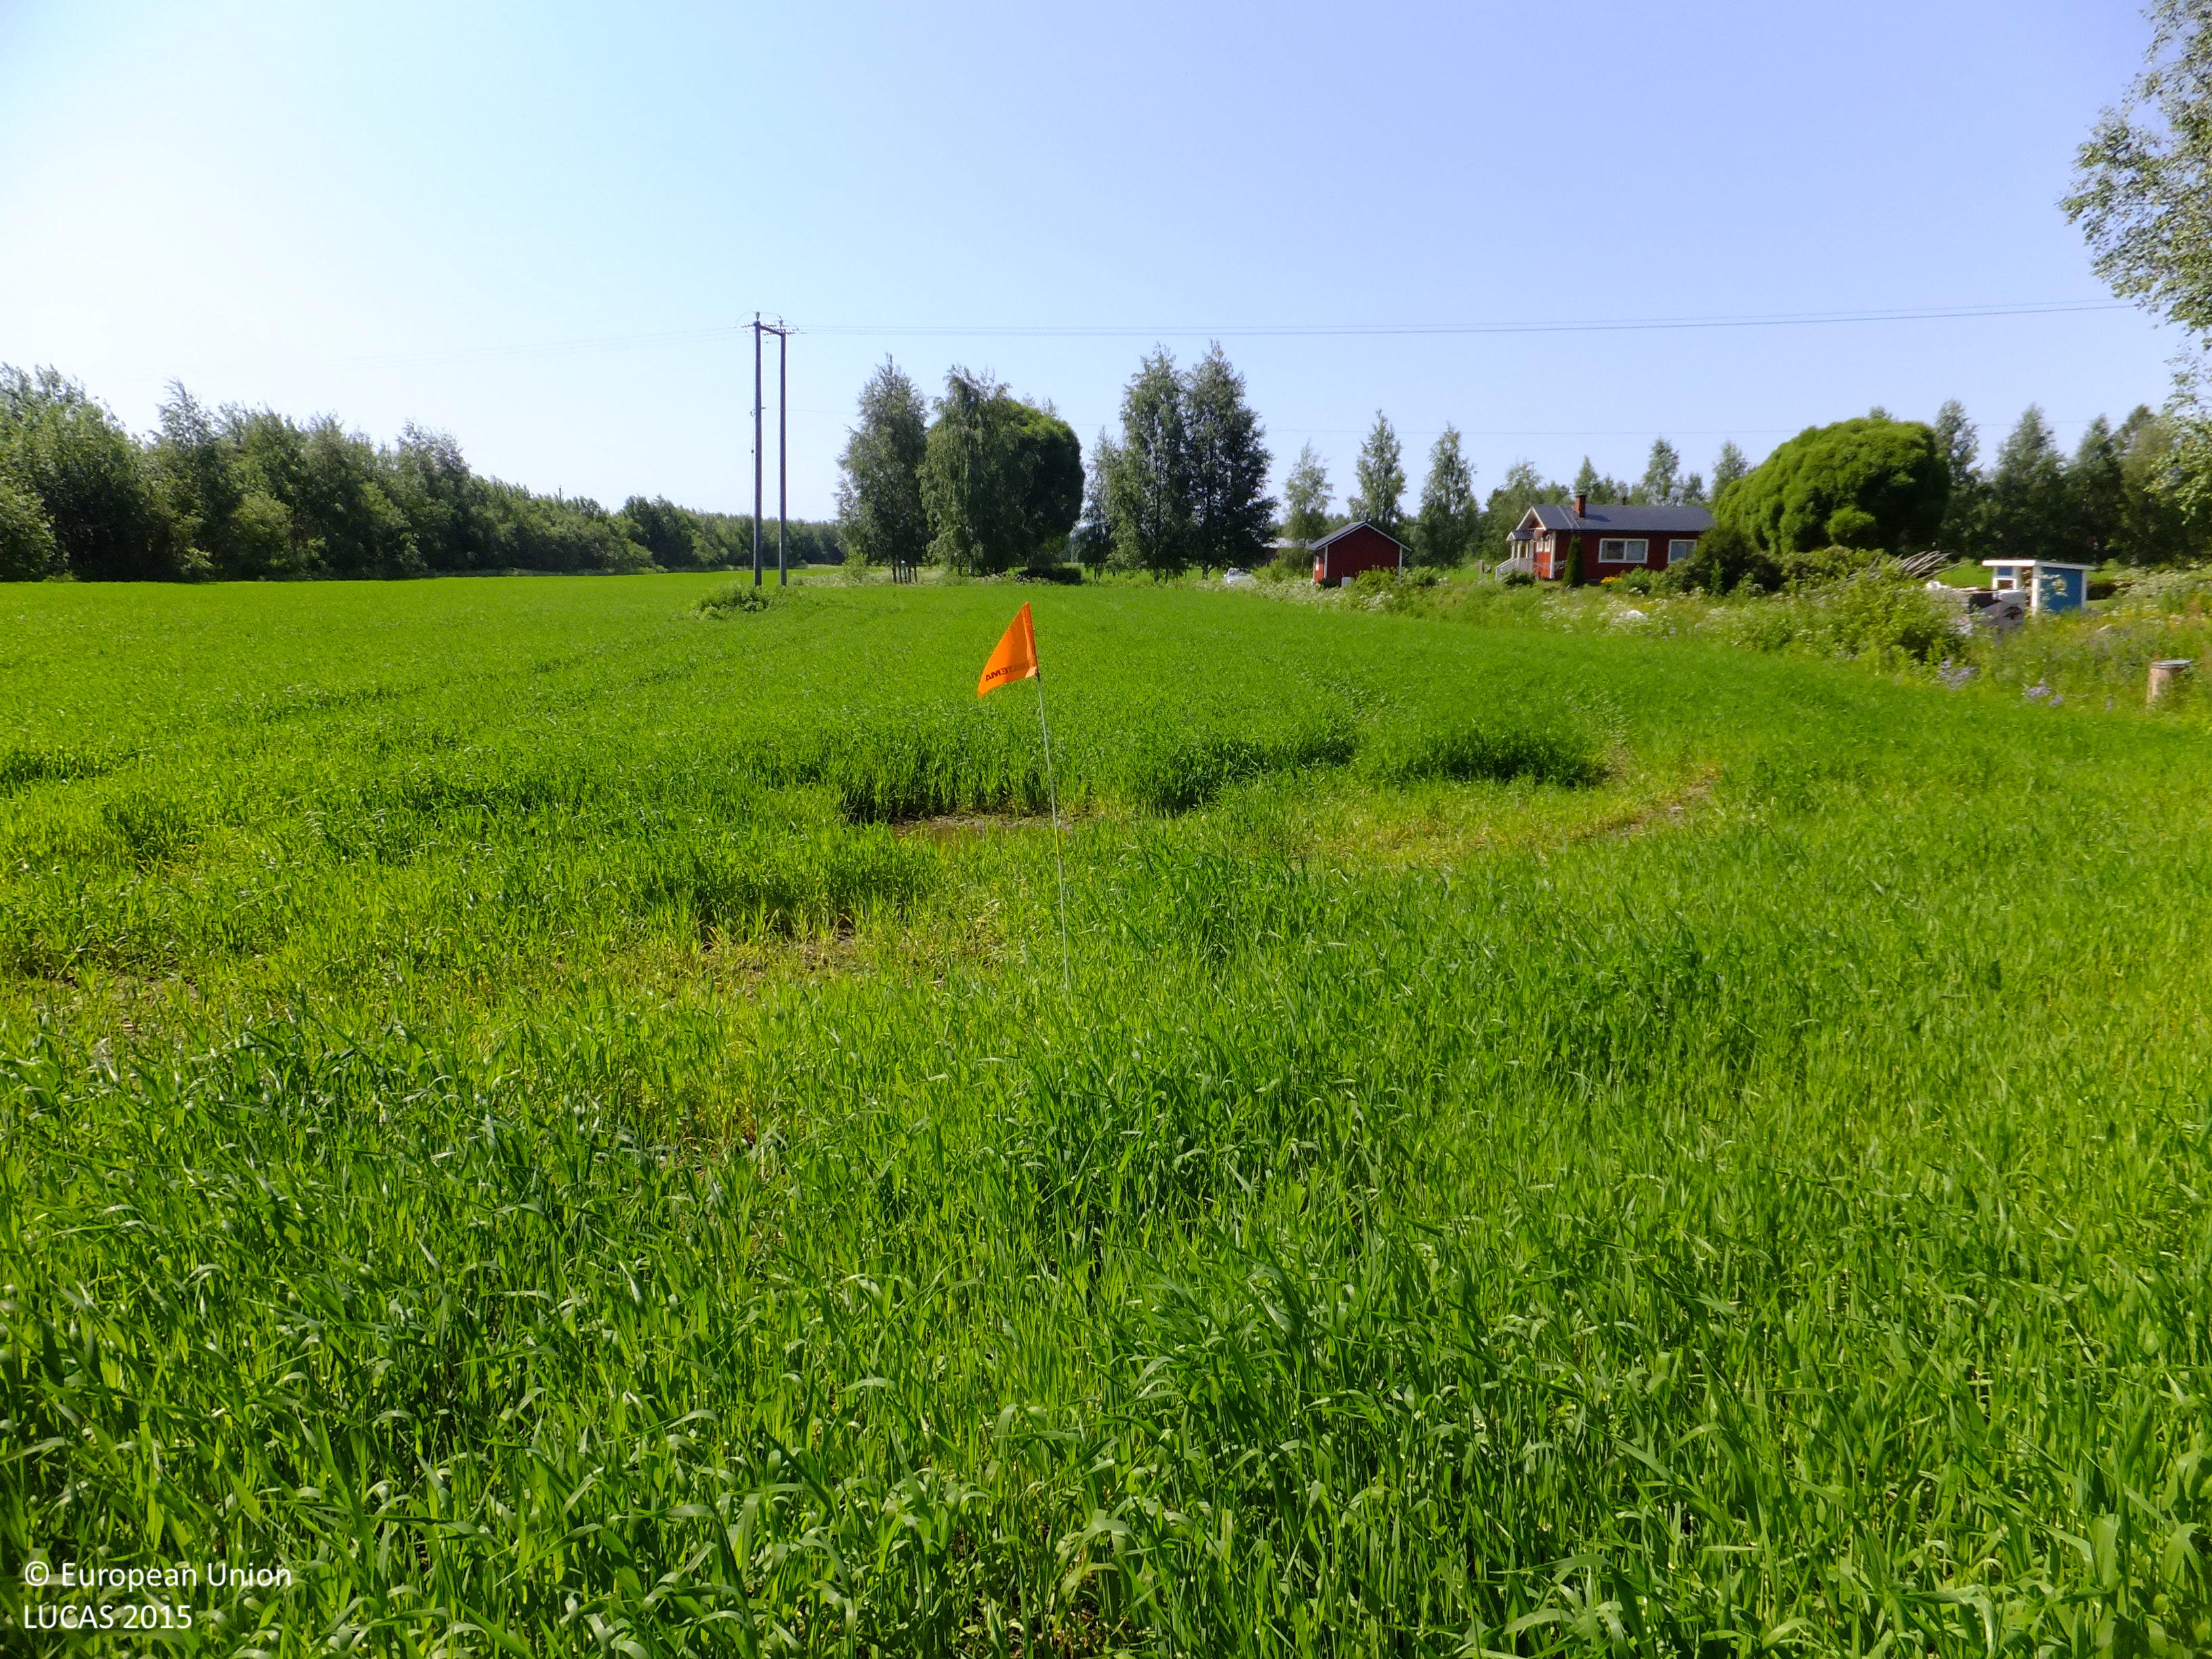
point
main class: Cropland
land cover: Barley
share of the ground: > 75 %
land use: Agriculture (excluding fallow land and kitchen gardens)
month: July
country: FI
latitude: 63.2272
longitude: 23.7388
